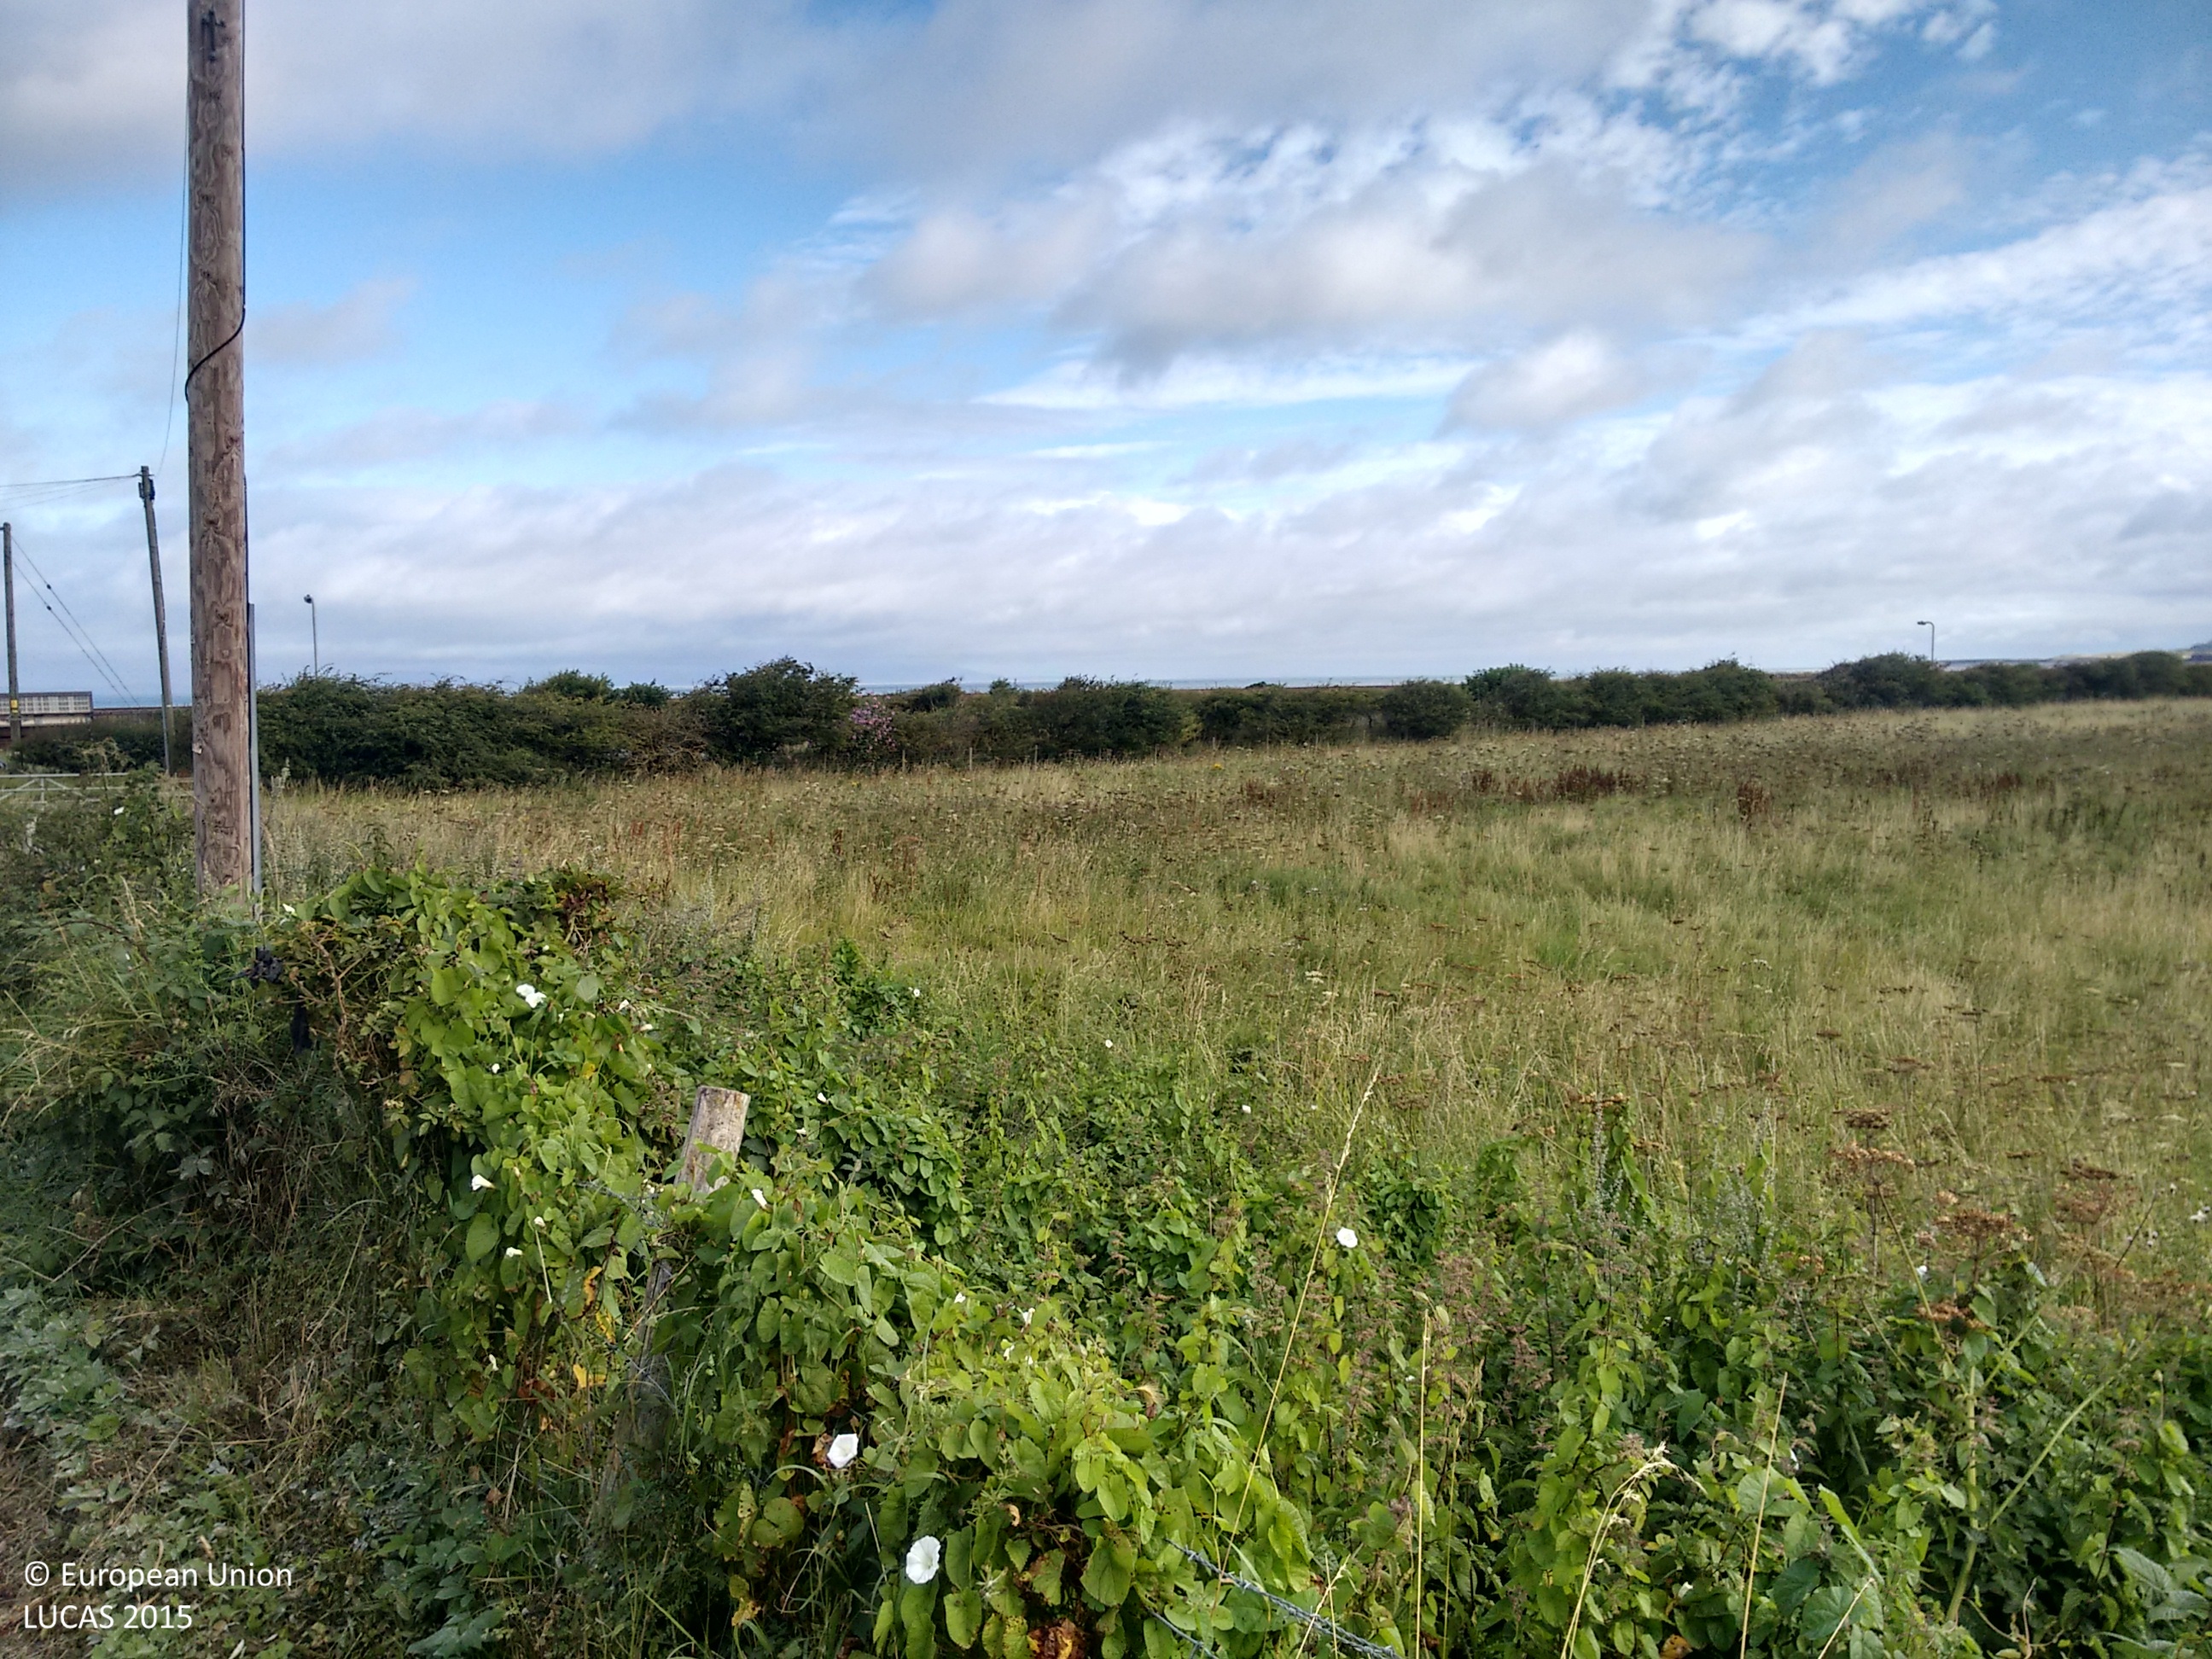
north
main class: Grassland
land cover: Spontaneously vegetated surfaces
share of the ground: > 75 %
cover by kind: herbaceous plants 100 %
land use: Fallow land
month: August
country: GB
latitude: 54.6817
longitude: -3.5295
